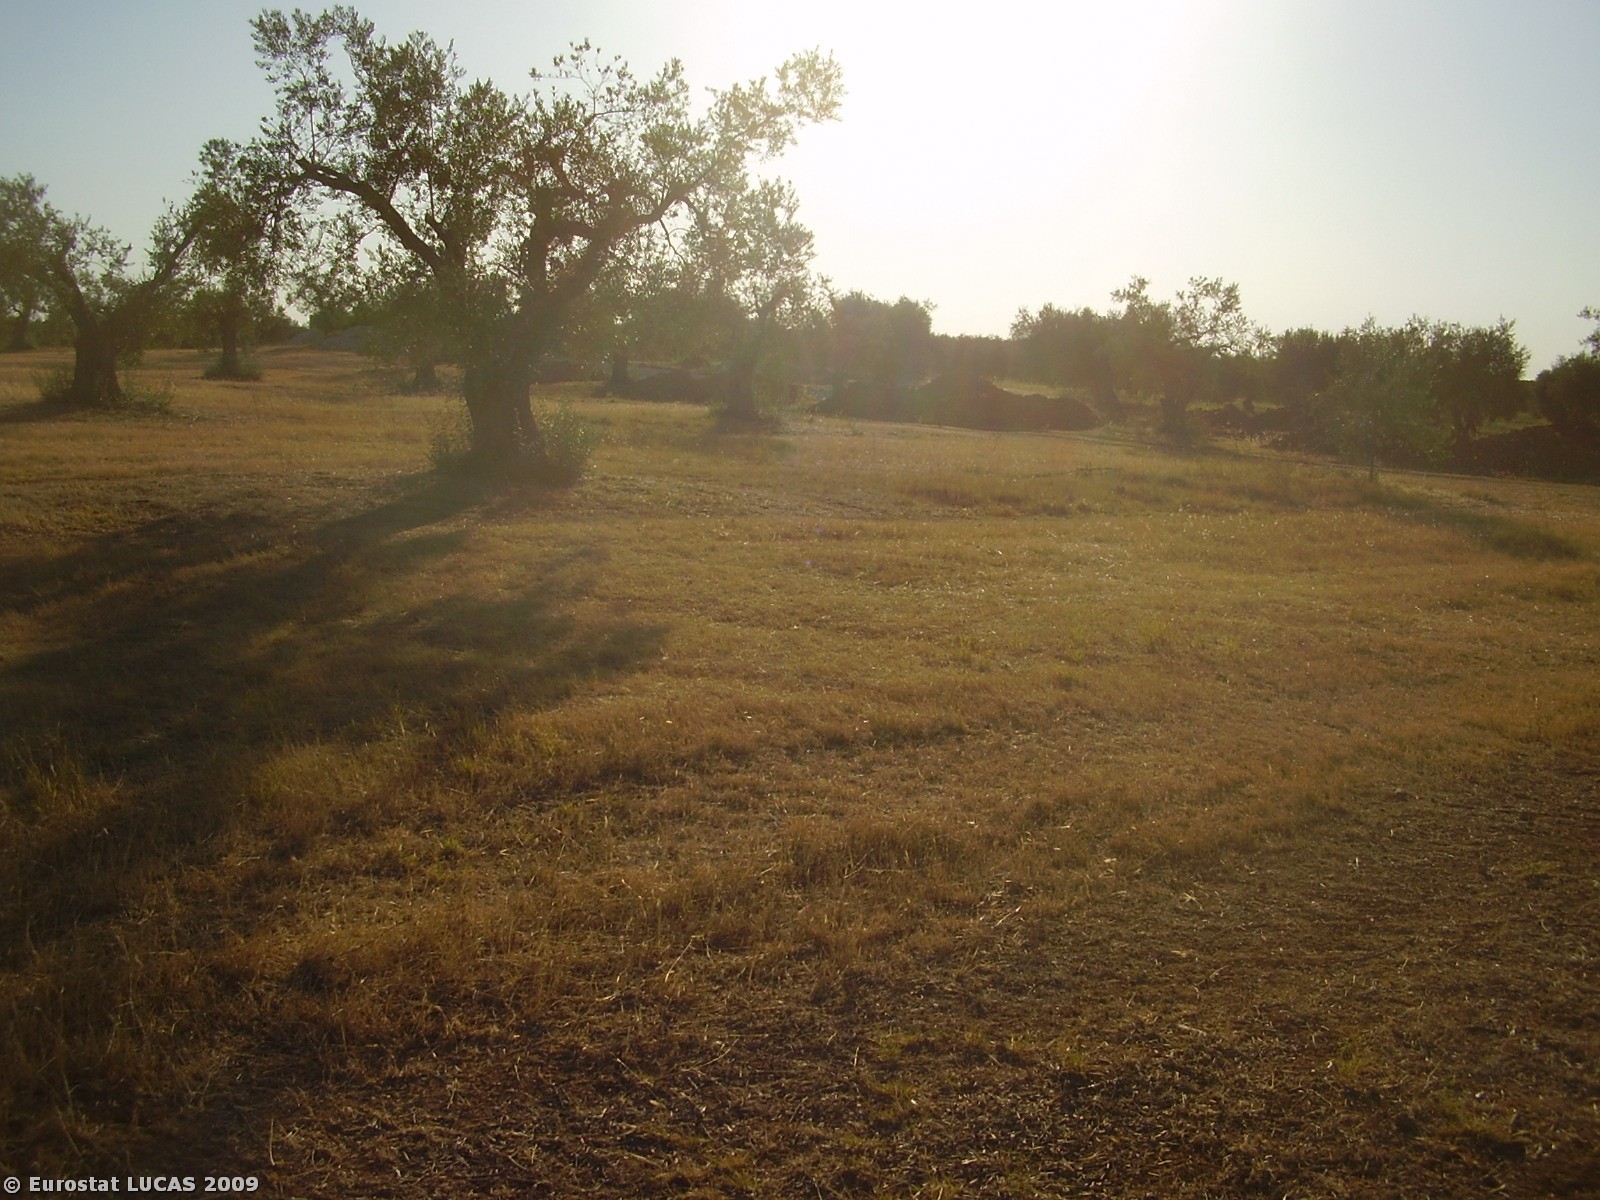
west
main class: Cropland
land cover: Olive groves
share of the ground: 10 - 25 %
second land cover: Mixed cereals for fodder
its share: > 75 %
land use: Agriculture (excluding fallow land and kitchen gardens)
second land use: Fallow land
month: August
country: PT
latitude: 38.0284
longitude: -7.5304
